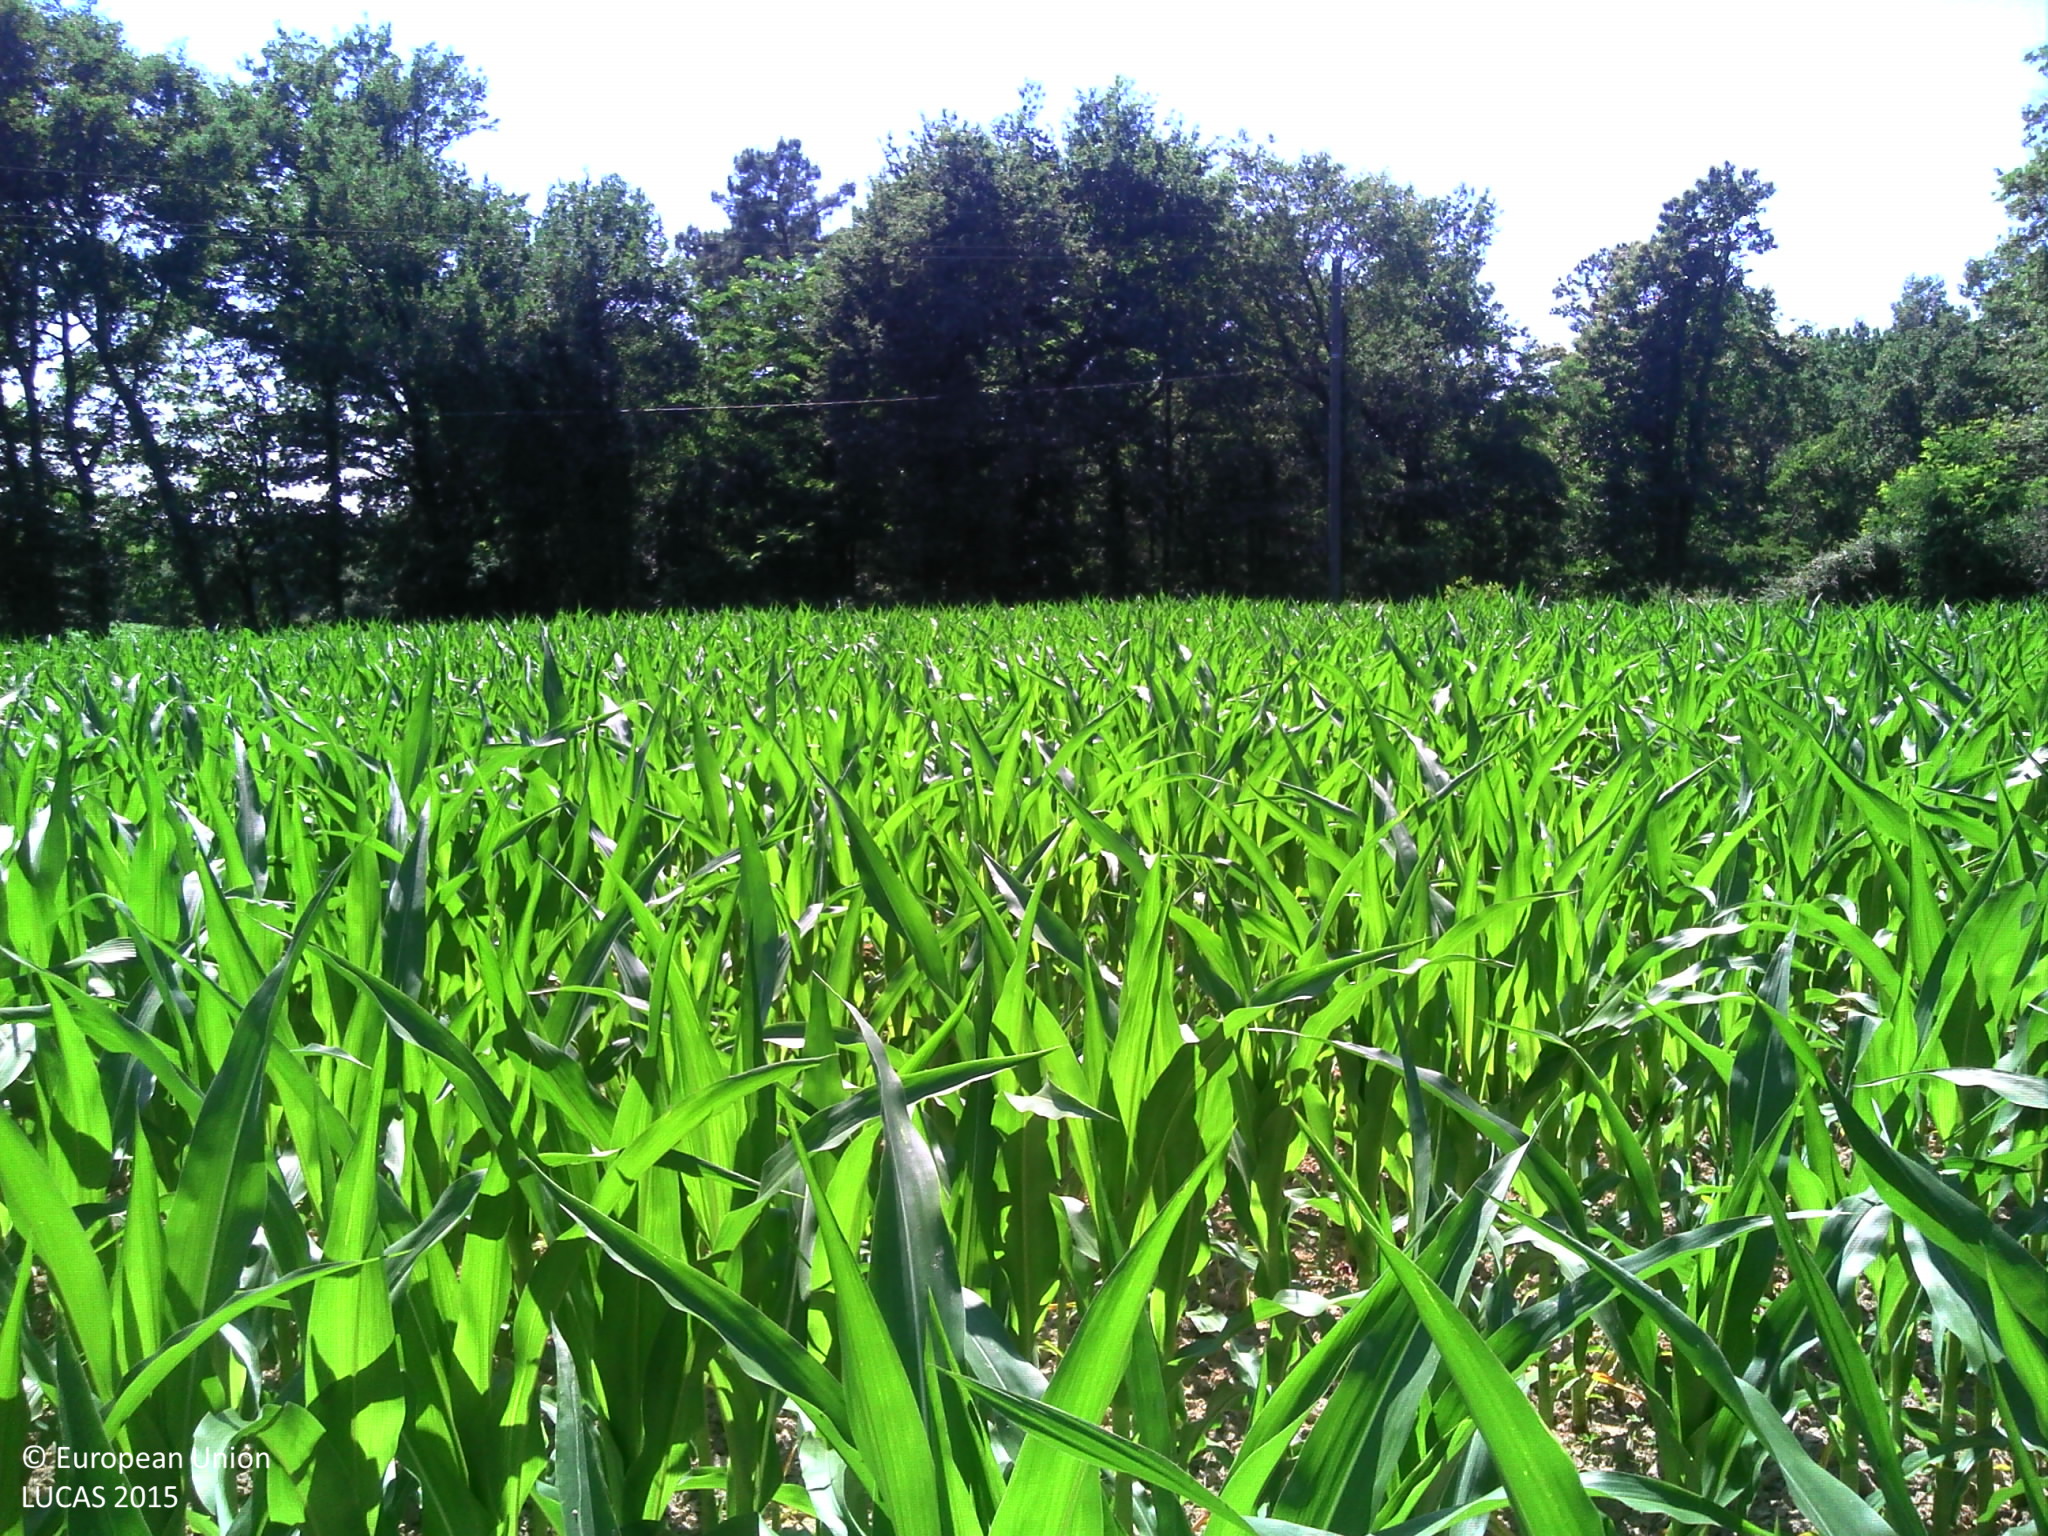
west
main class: Cropland
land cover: Maize
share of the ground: > 75 %
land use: Agriculture (excluding fallow land and kitchen gardens)
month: June
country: FR
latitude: 43.7940
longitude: -0.3626
